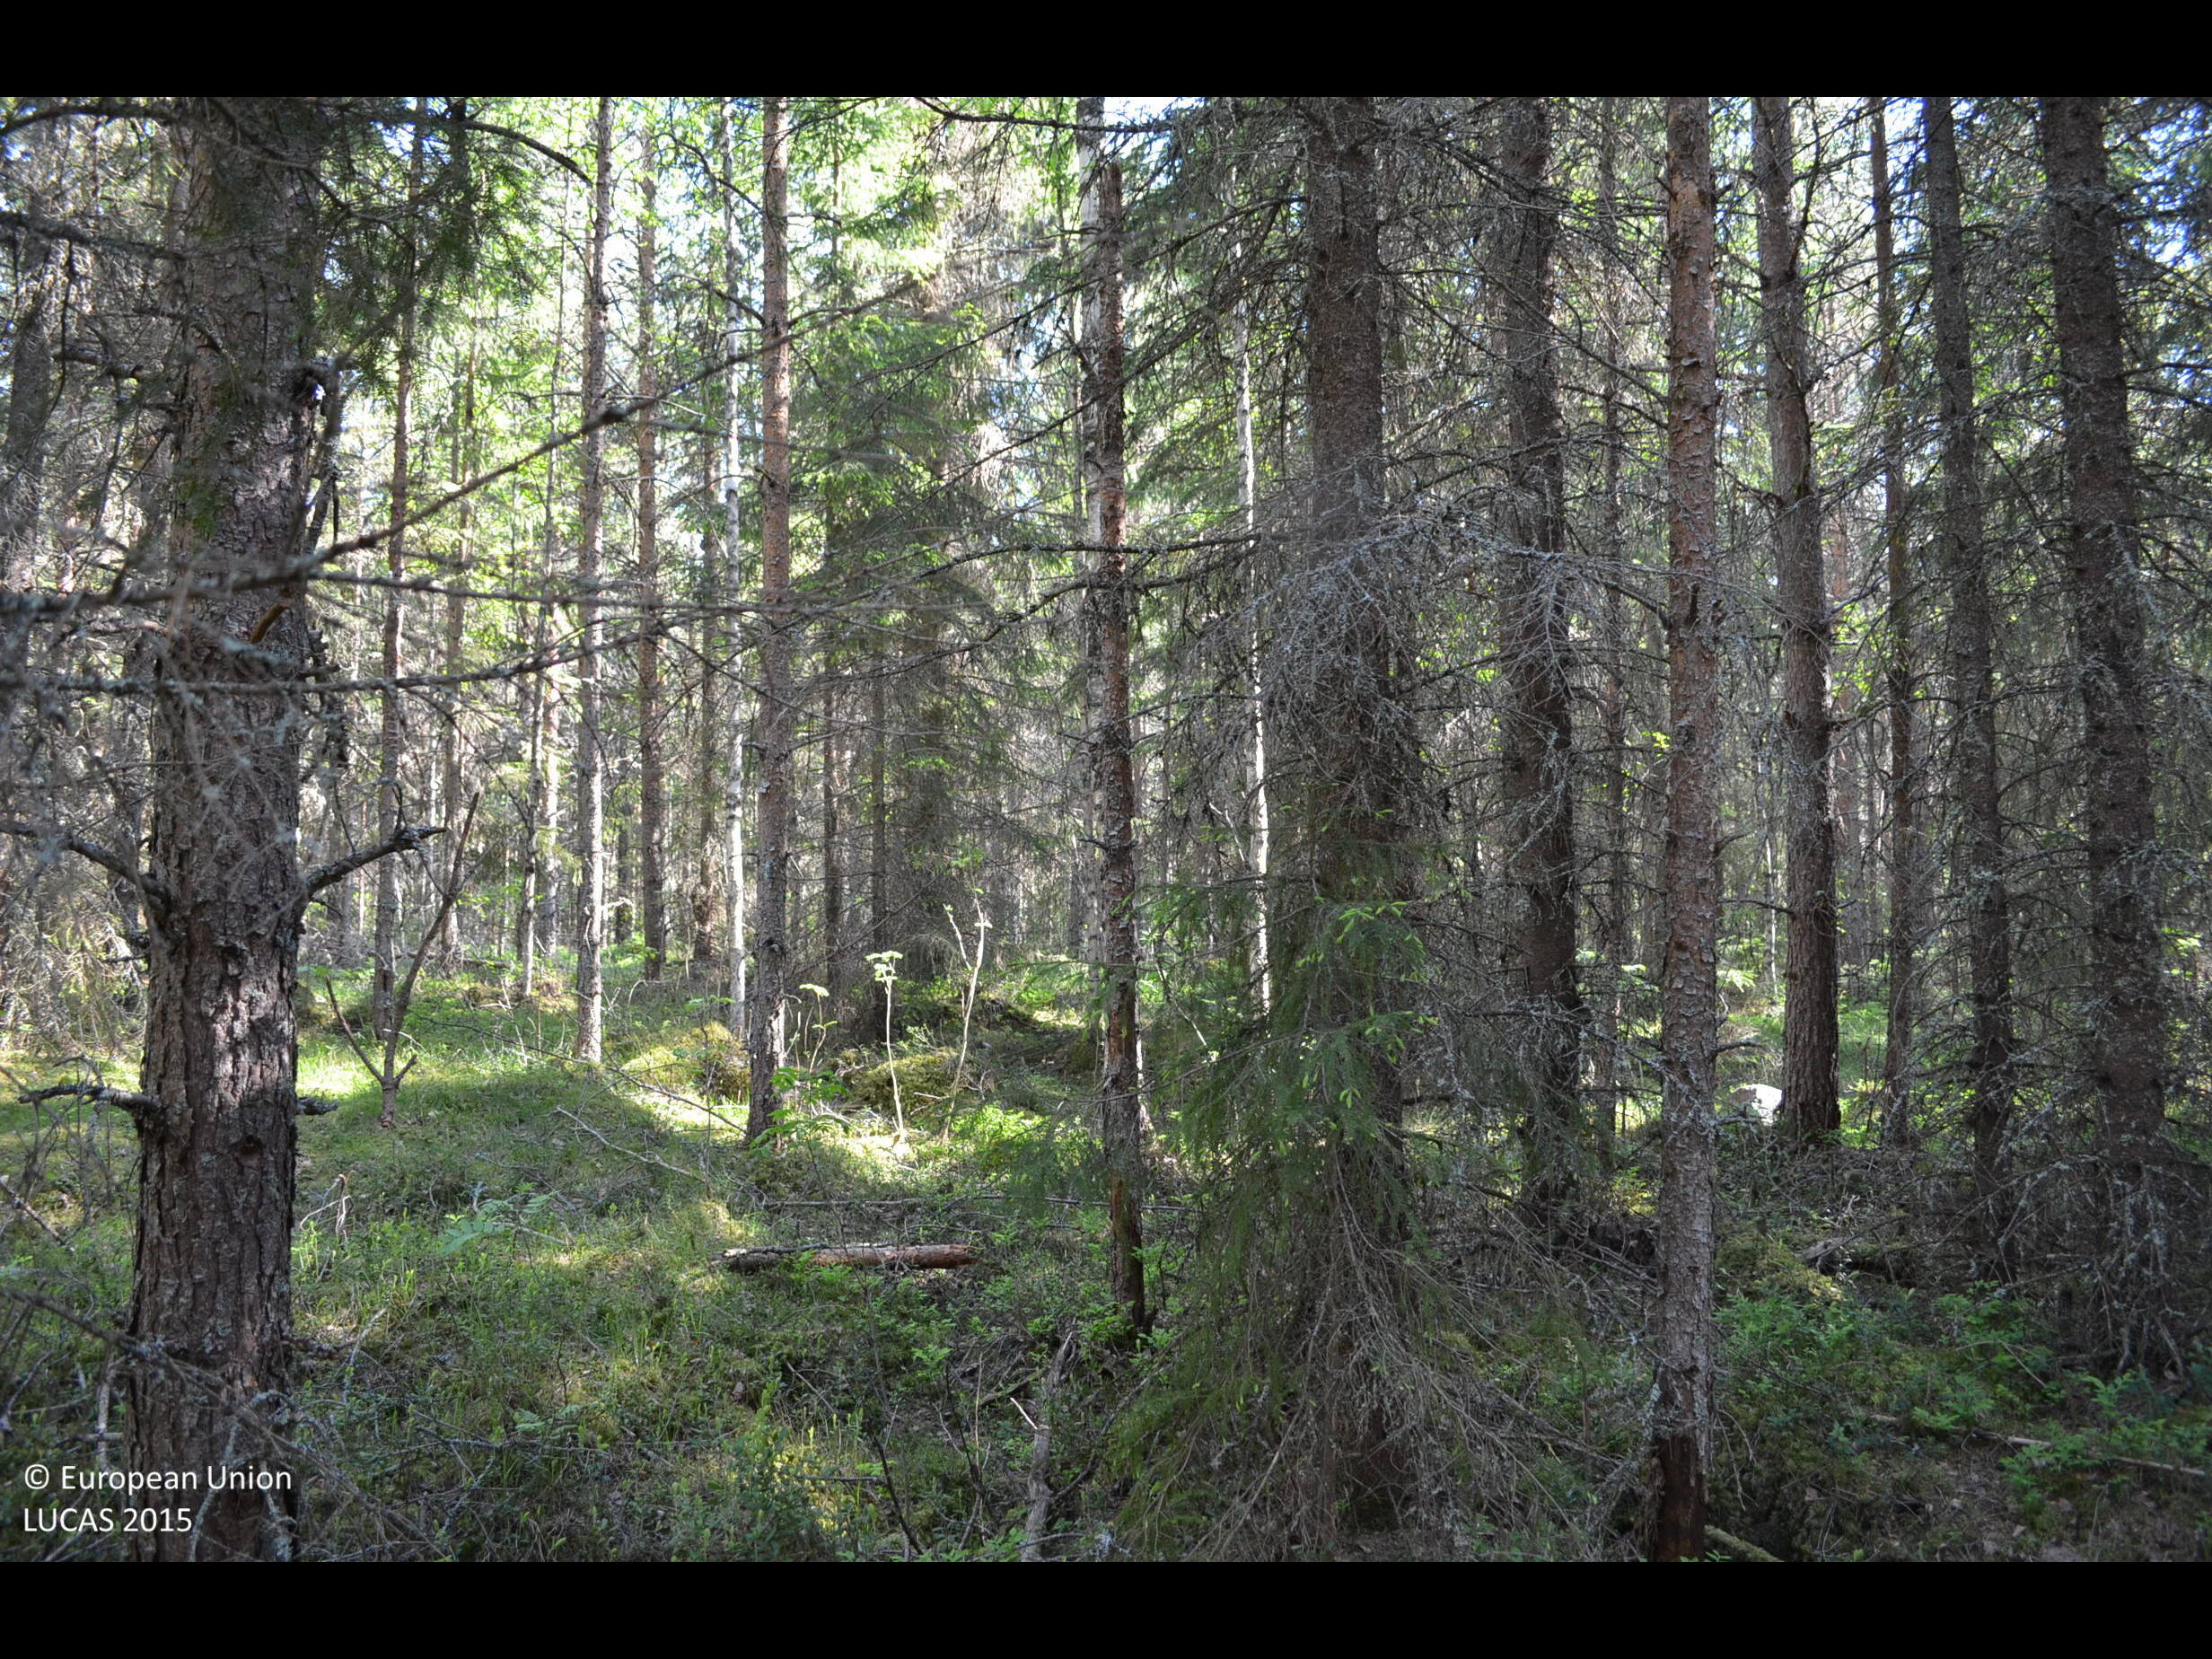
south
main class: Woodland
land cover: Pine dominated coniferous woodland
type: boreal forest
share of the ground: > 75 %
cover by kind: coniferous forest trees 80 %, shrubs 15 %, broadleaved forest trees 5 %
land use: Forestry
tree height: > 5 m
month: June
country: FI
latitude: 61.9121
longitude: 23.2661
